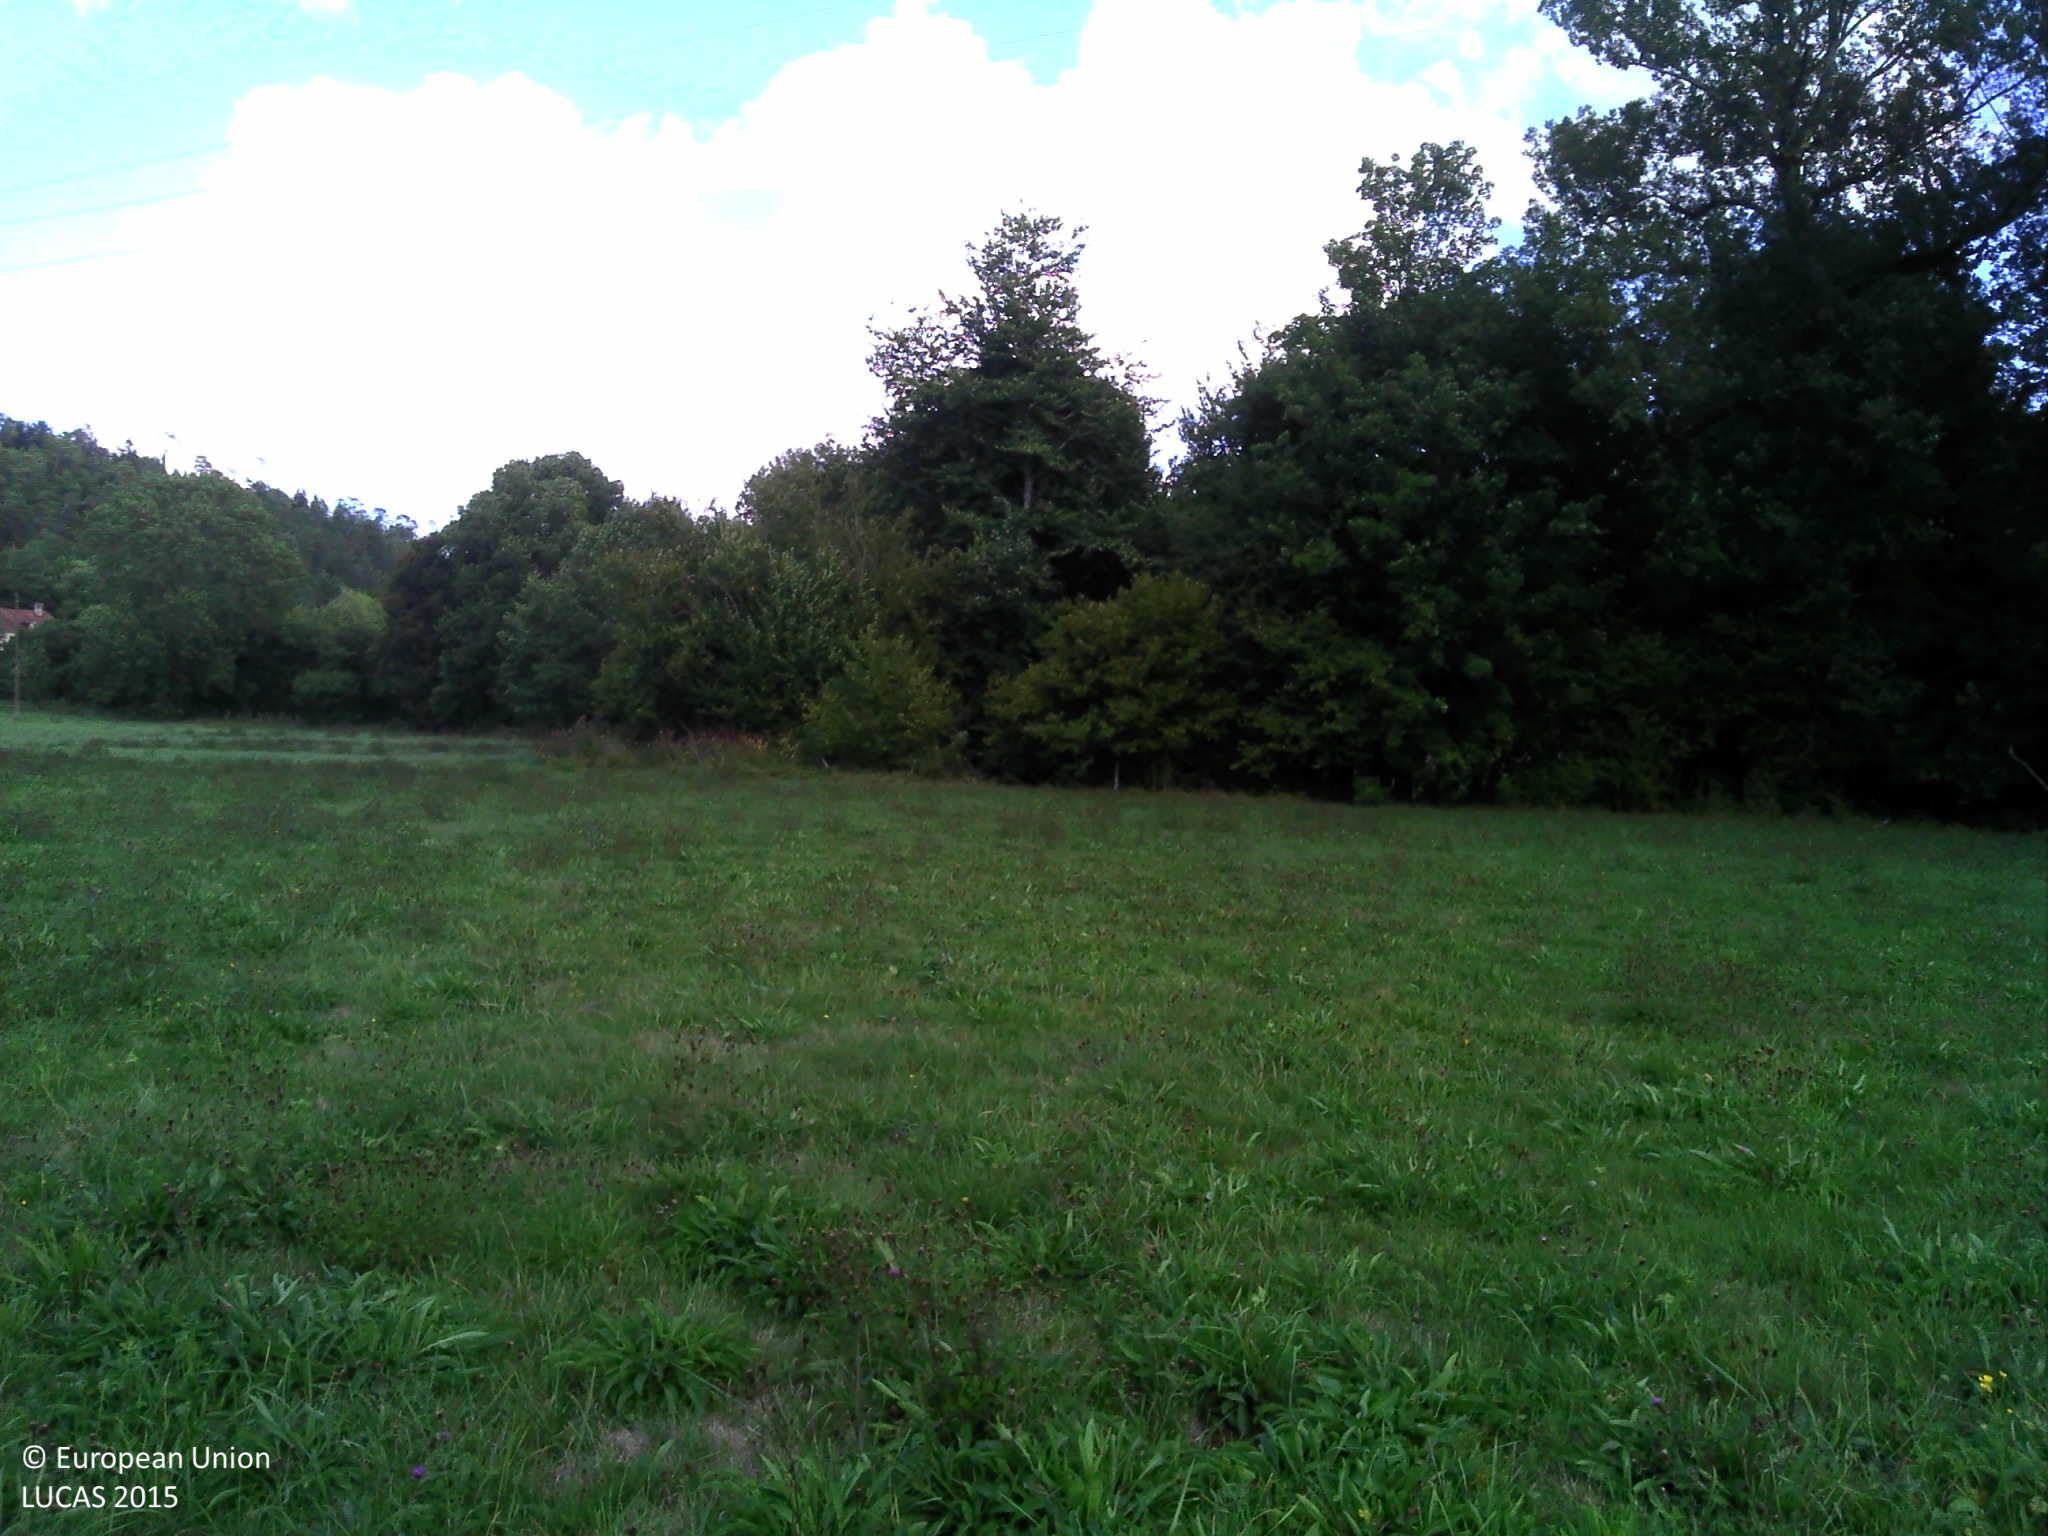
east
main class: Grassland
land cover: Grassland without tree/shrub cover
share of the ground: > 75 %
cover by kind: herbaceous plants 90 %, lichens and mosses 5 %, consolidated bare surface 5 %
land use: Agriculture (excluding fallow land and kitchen gardens)
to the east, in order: Grassland without tree/shrub cover; Fences; Abandoned hedges; Rivers and streams; Abandoned hedges; Artificial constructions in urban areas; Broadleaved woodland; Inland fresh running water; Broadleaved woodland; Inland fresh running water; Abandoned hedges; Grassland without tree/shrub cover
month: August
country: FR
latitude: 45.3680
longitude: 0.7327
